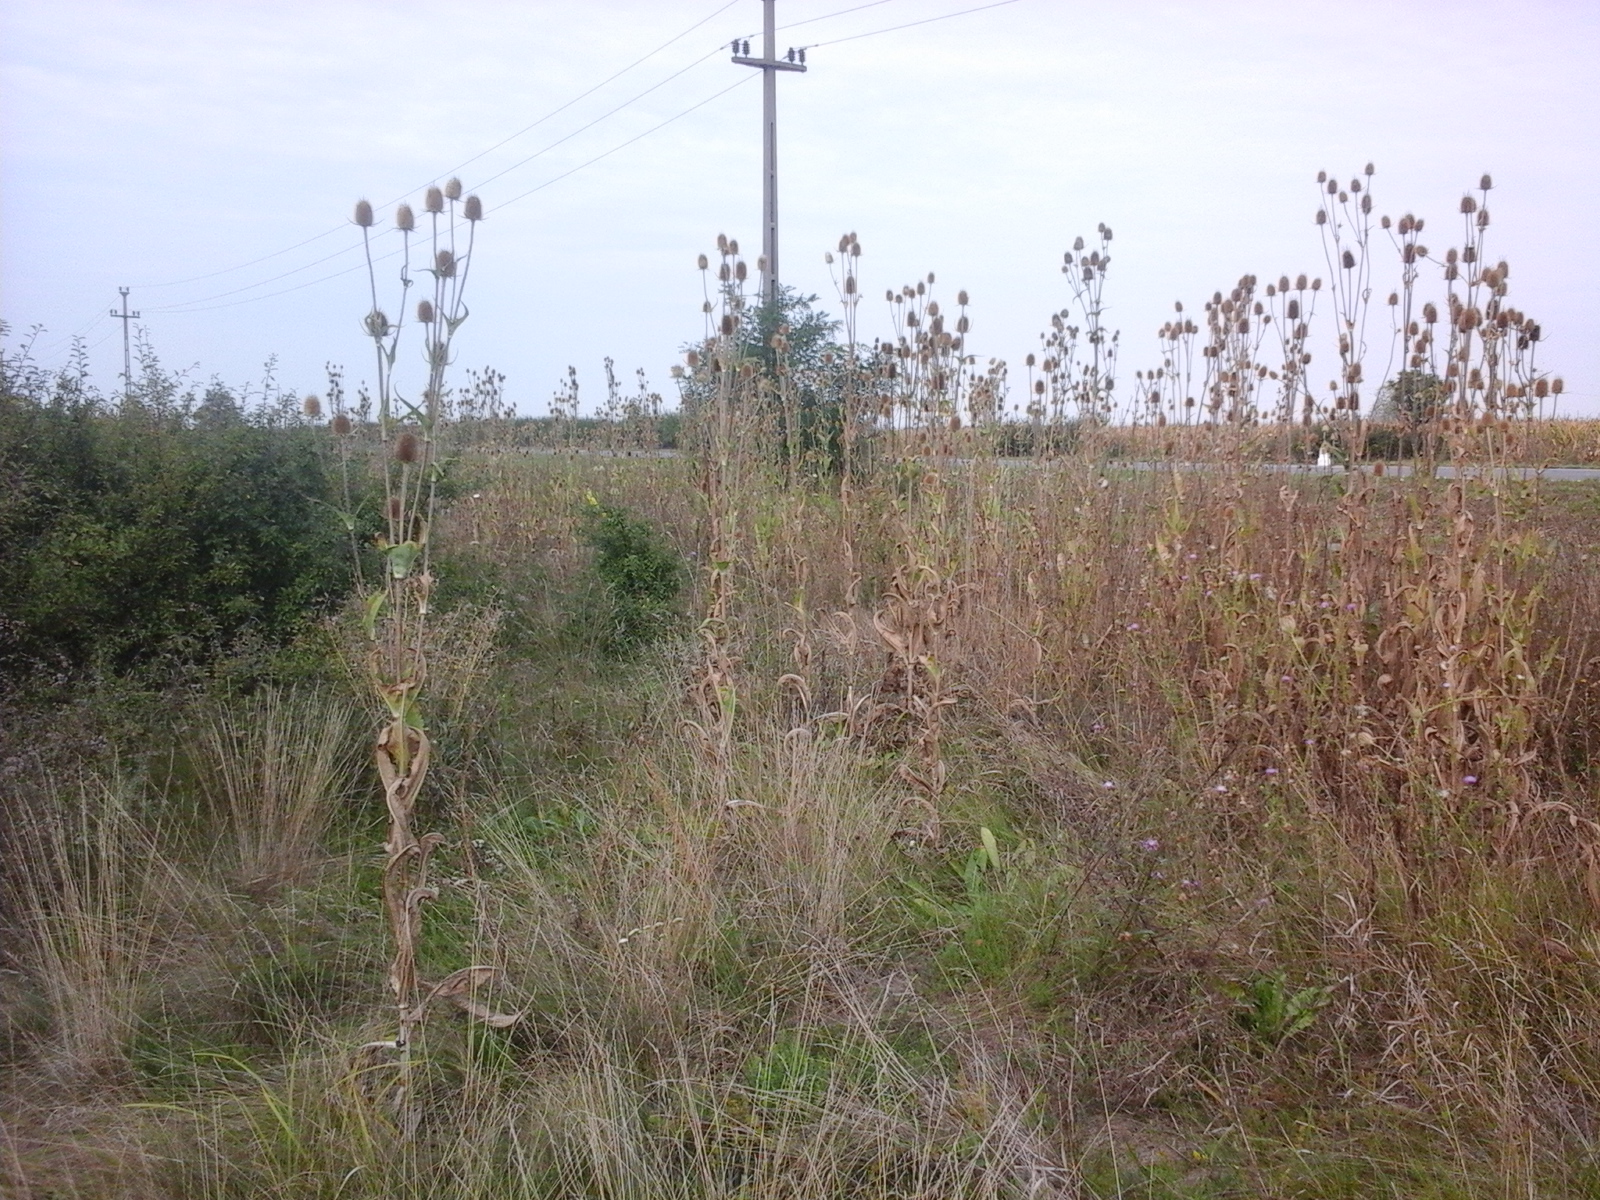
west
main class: Cropland
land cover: Maize
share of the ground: > 75 %
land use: Agriculture (excluding fallow land and kitchen gardens)
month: August
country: RO
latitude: 46.7899
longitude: 21.6079
